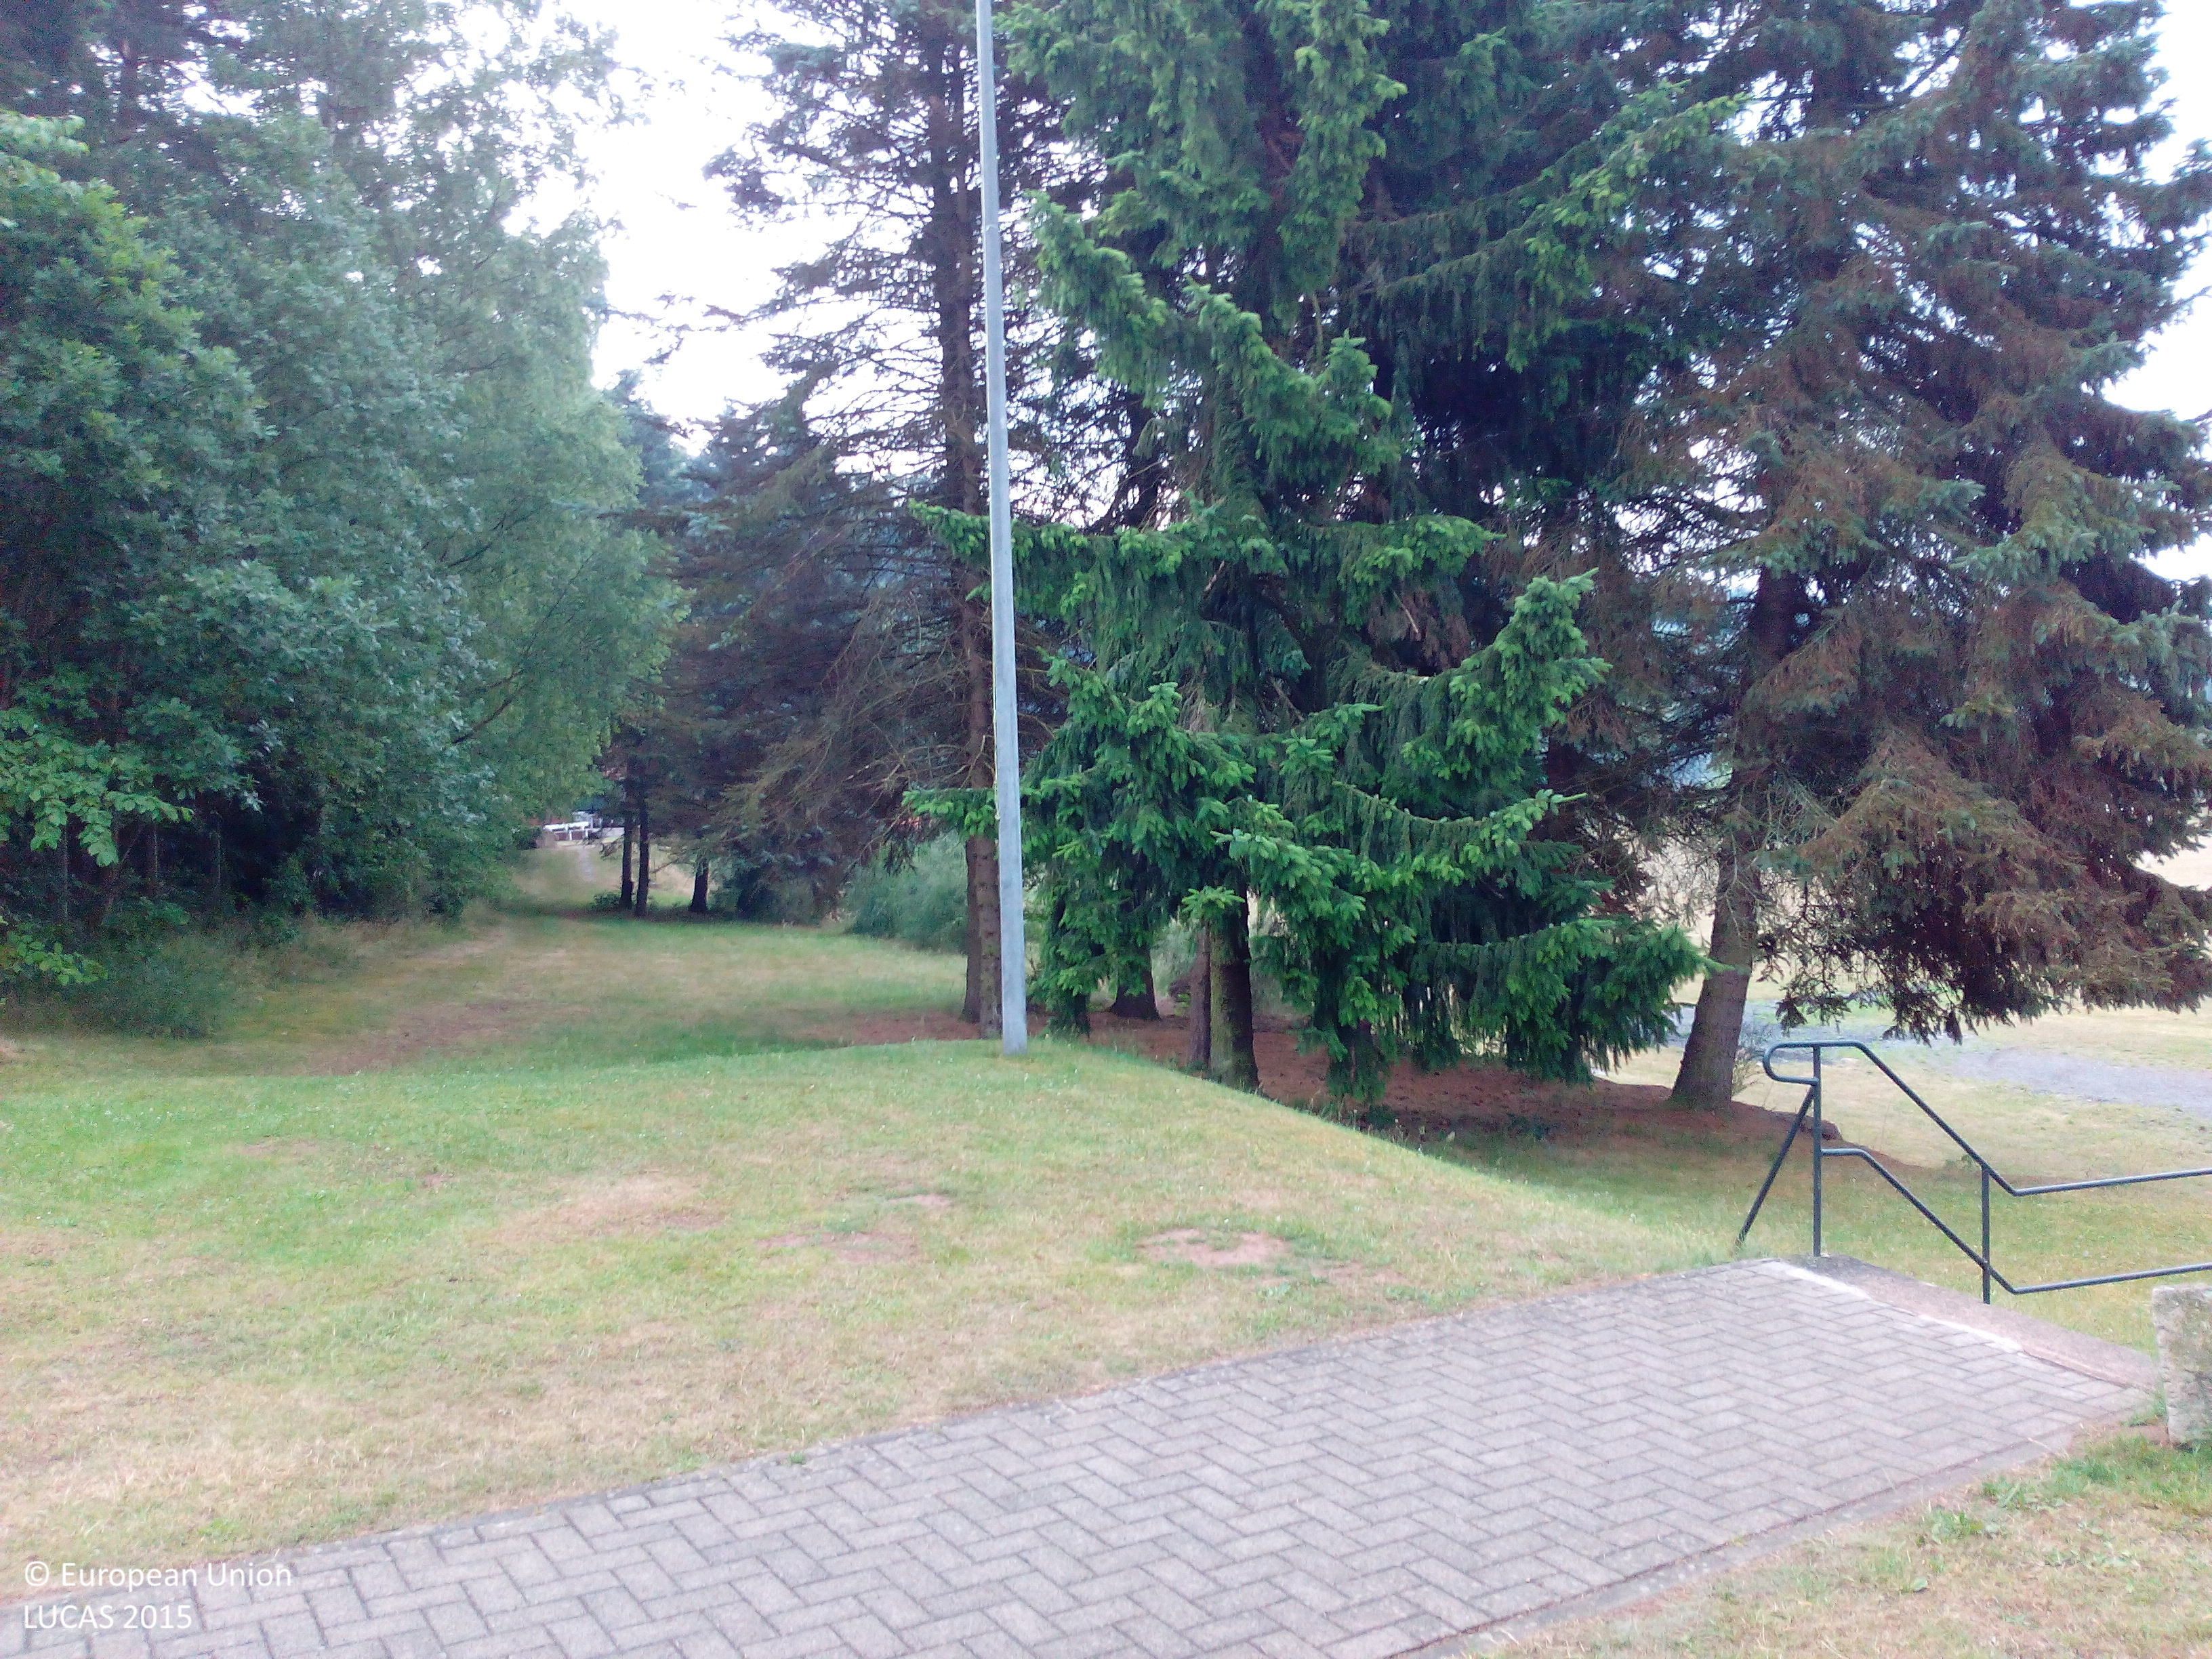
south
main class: Grassland
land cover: Grassland without tree/shrub cover
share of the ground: > 75 %
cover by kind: herbaceous plants 100 %
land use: Sport
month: July
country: DE
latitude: 51.4423
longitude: 9.6692
